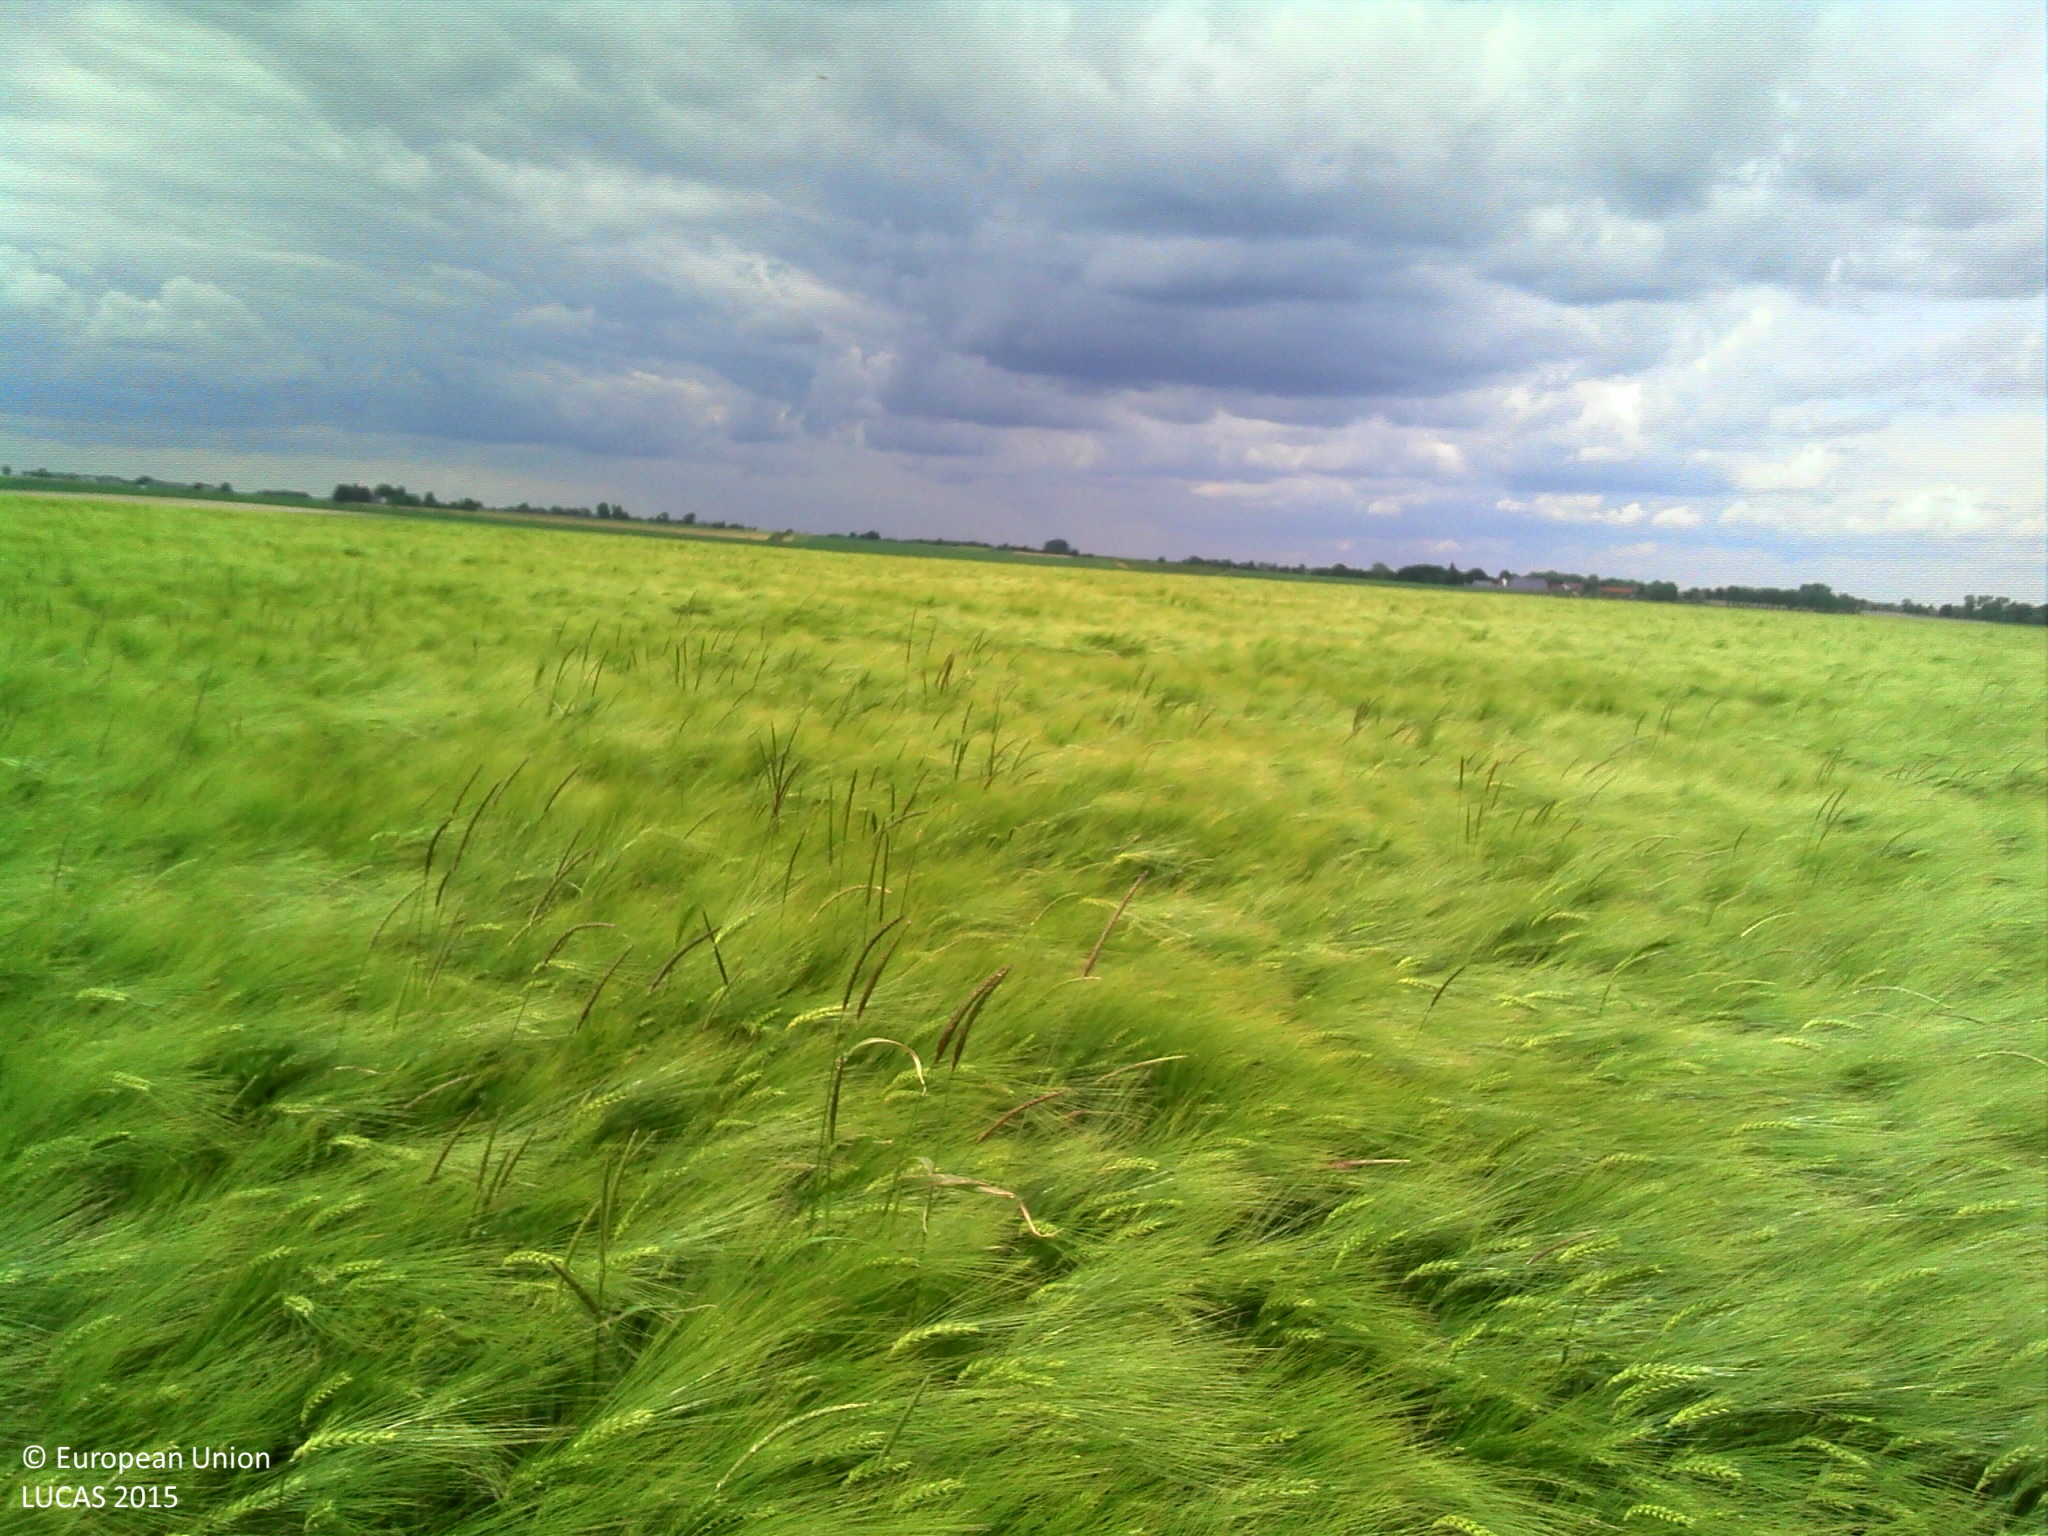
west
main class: Cropland
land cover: Barley
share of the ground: > 75 %
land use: Agriculture (excluding fallow land and kitchen gardens)
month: May
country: BE
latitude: 50.6592
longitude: 4.7767
